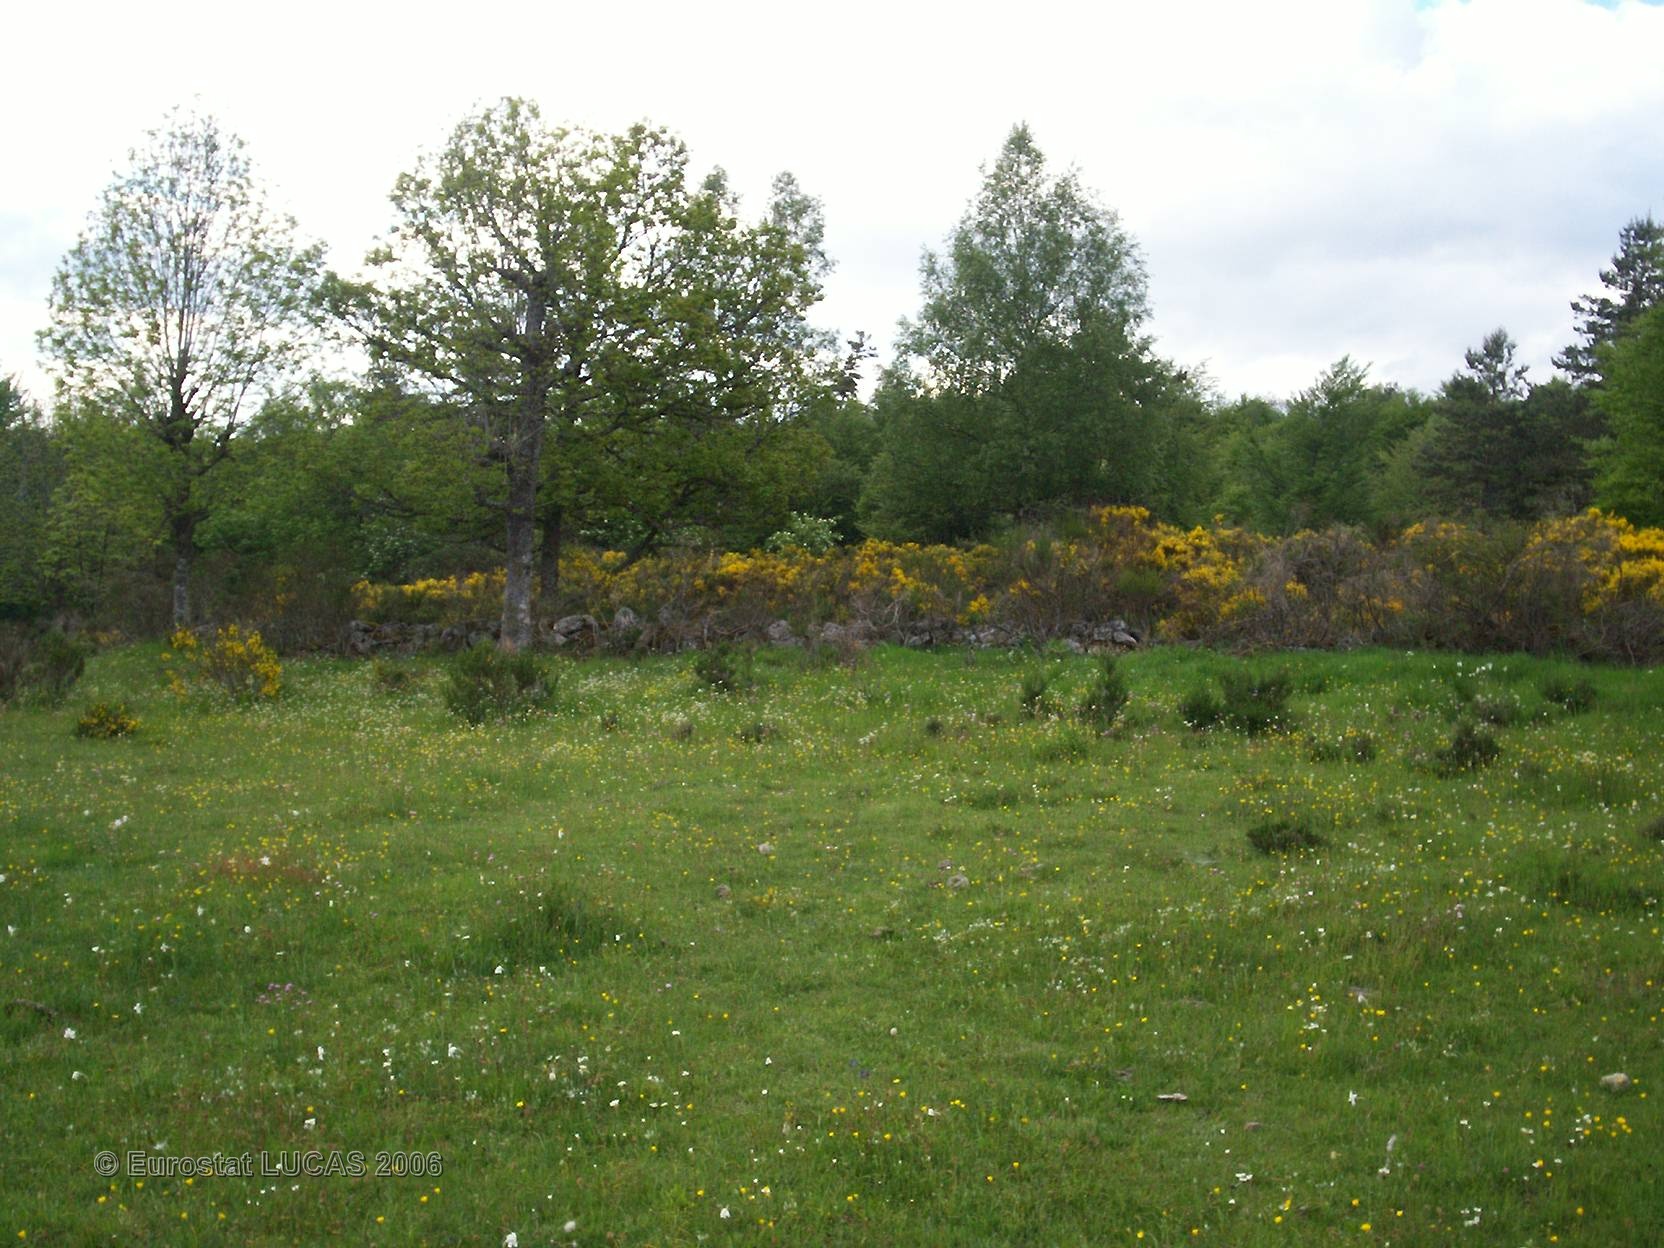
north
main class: Grassland
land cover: Grassland without tree/shrub cover
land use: Agriculture (excluding fallow land and kitchen gardens)
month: May
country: FR
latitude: 44.6295
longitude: 3.4122
